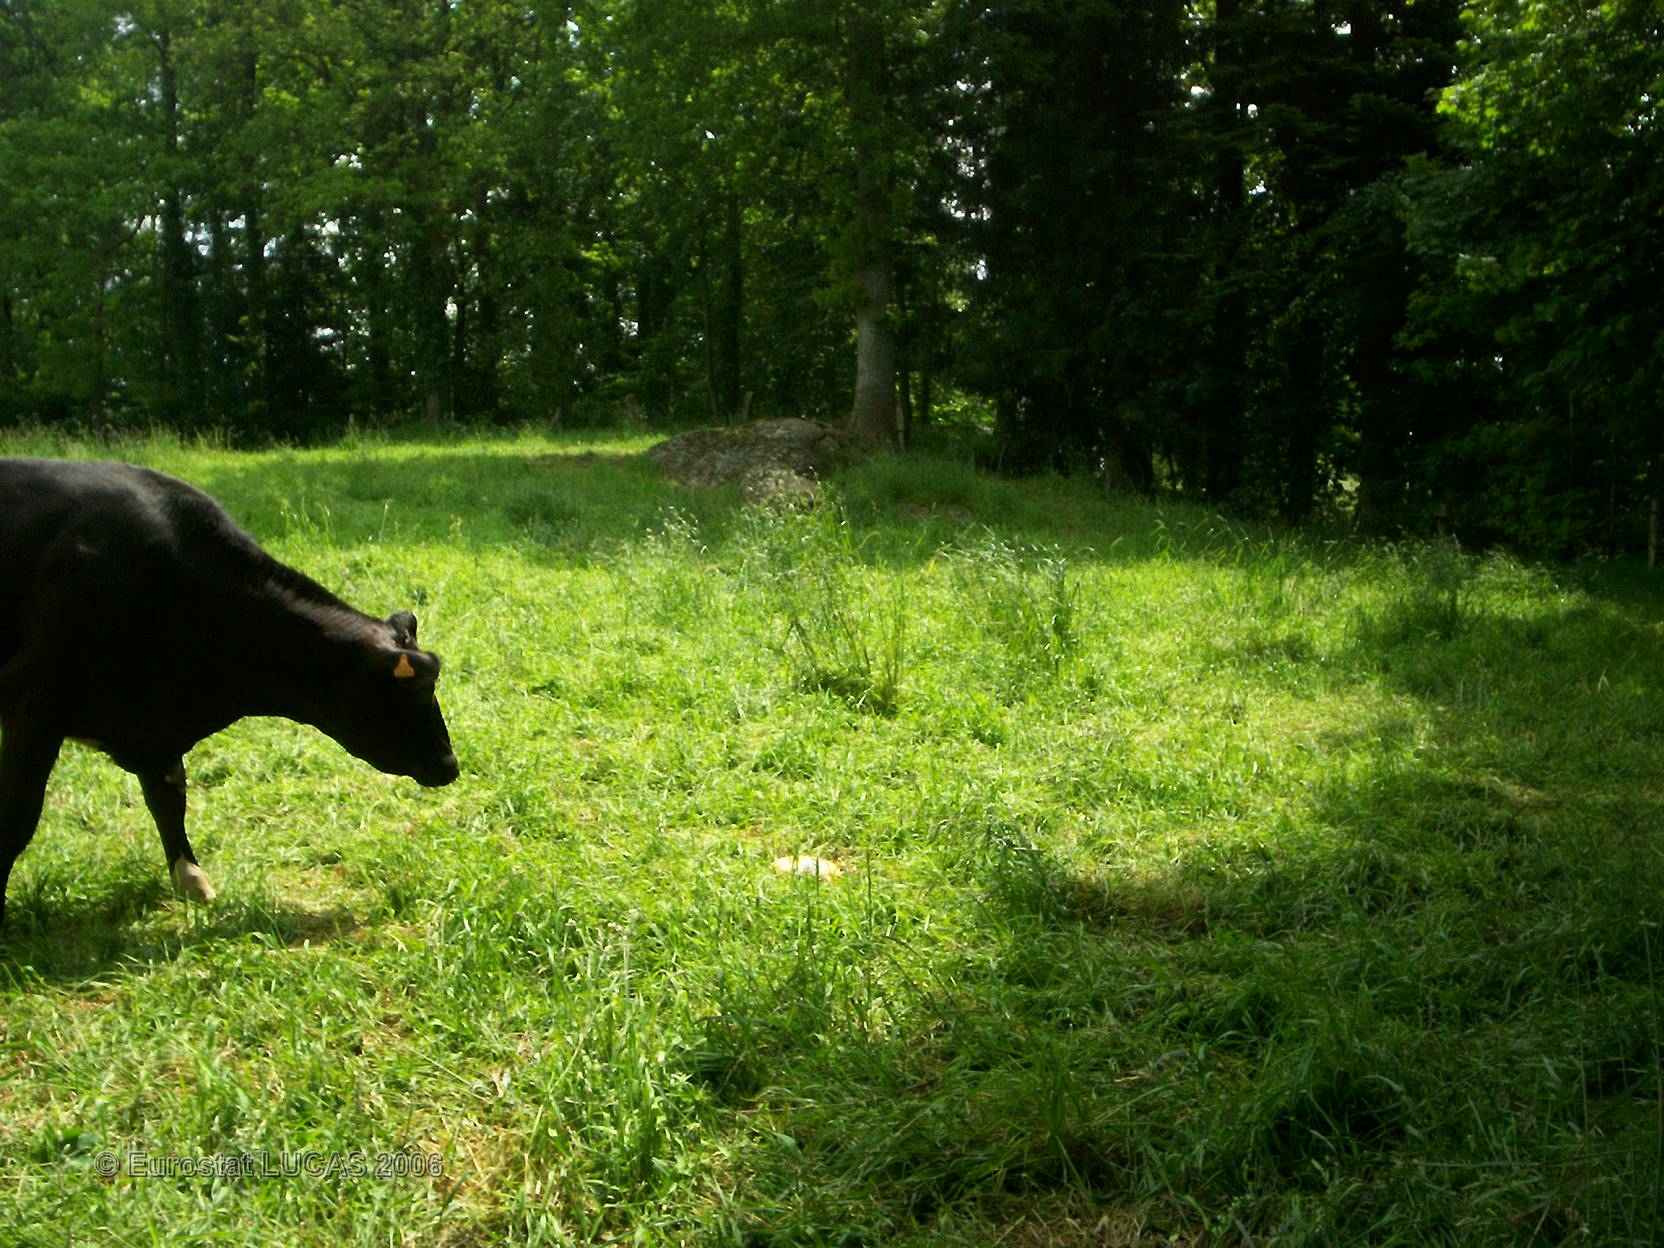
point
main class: Grassland
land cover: Grassland without tree/shrub cover
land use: Agriculture (excluding fallow land and kitchen gardens)
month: June
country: FR
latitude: 48.4654
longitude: -1.2281
